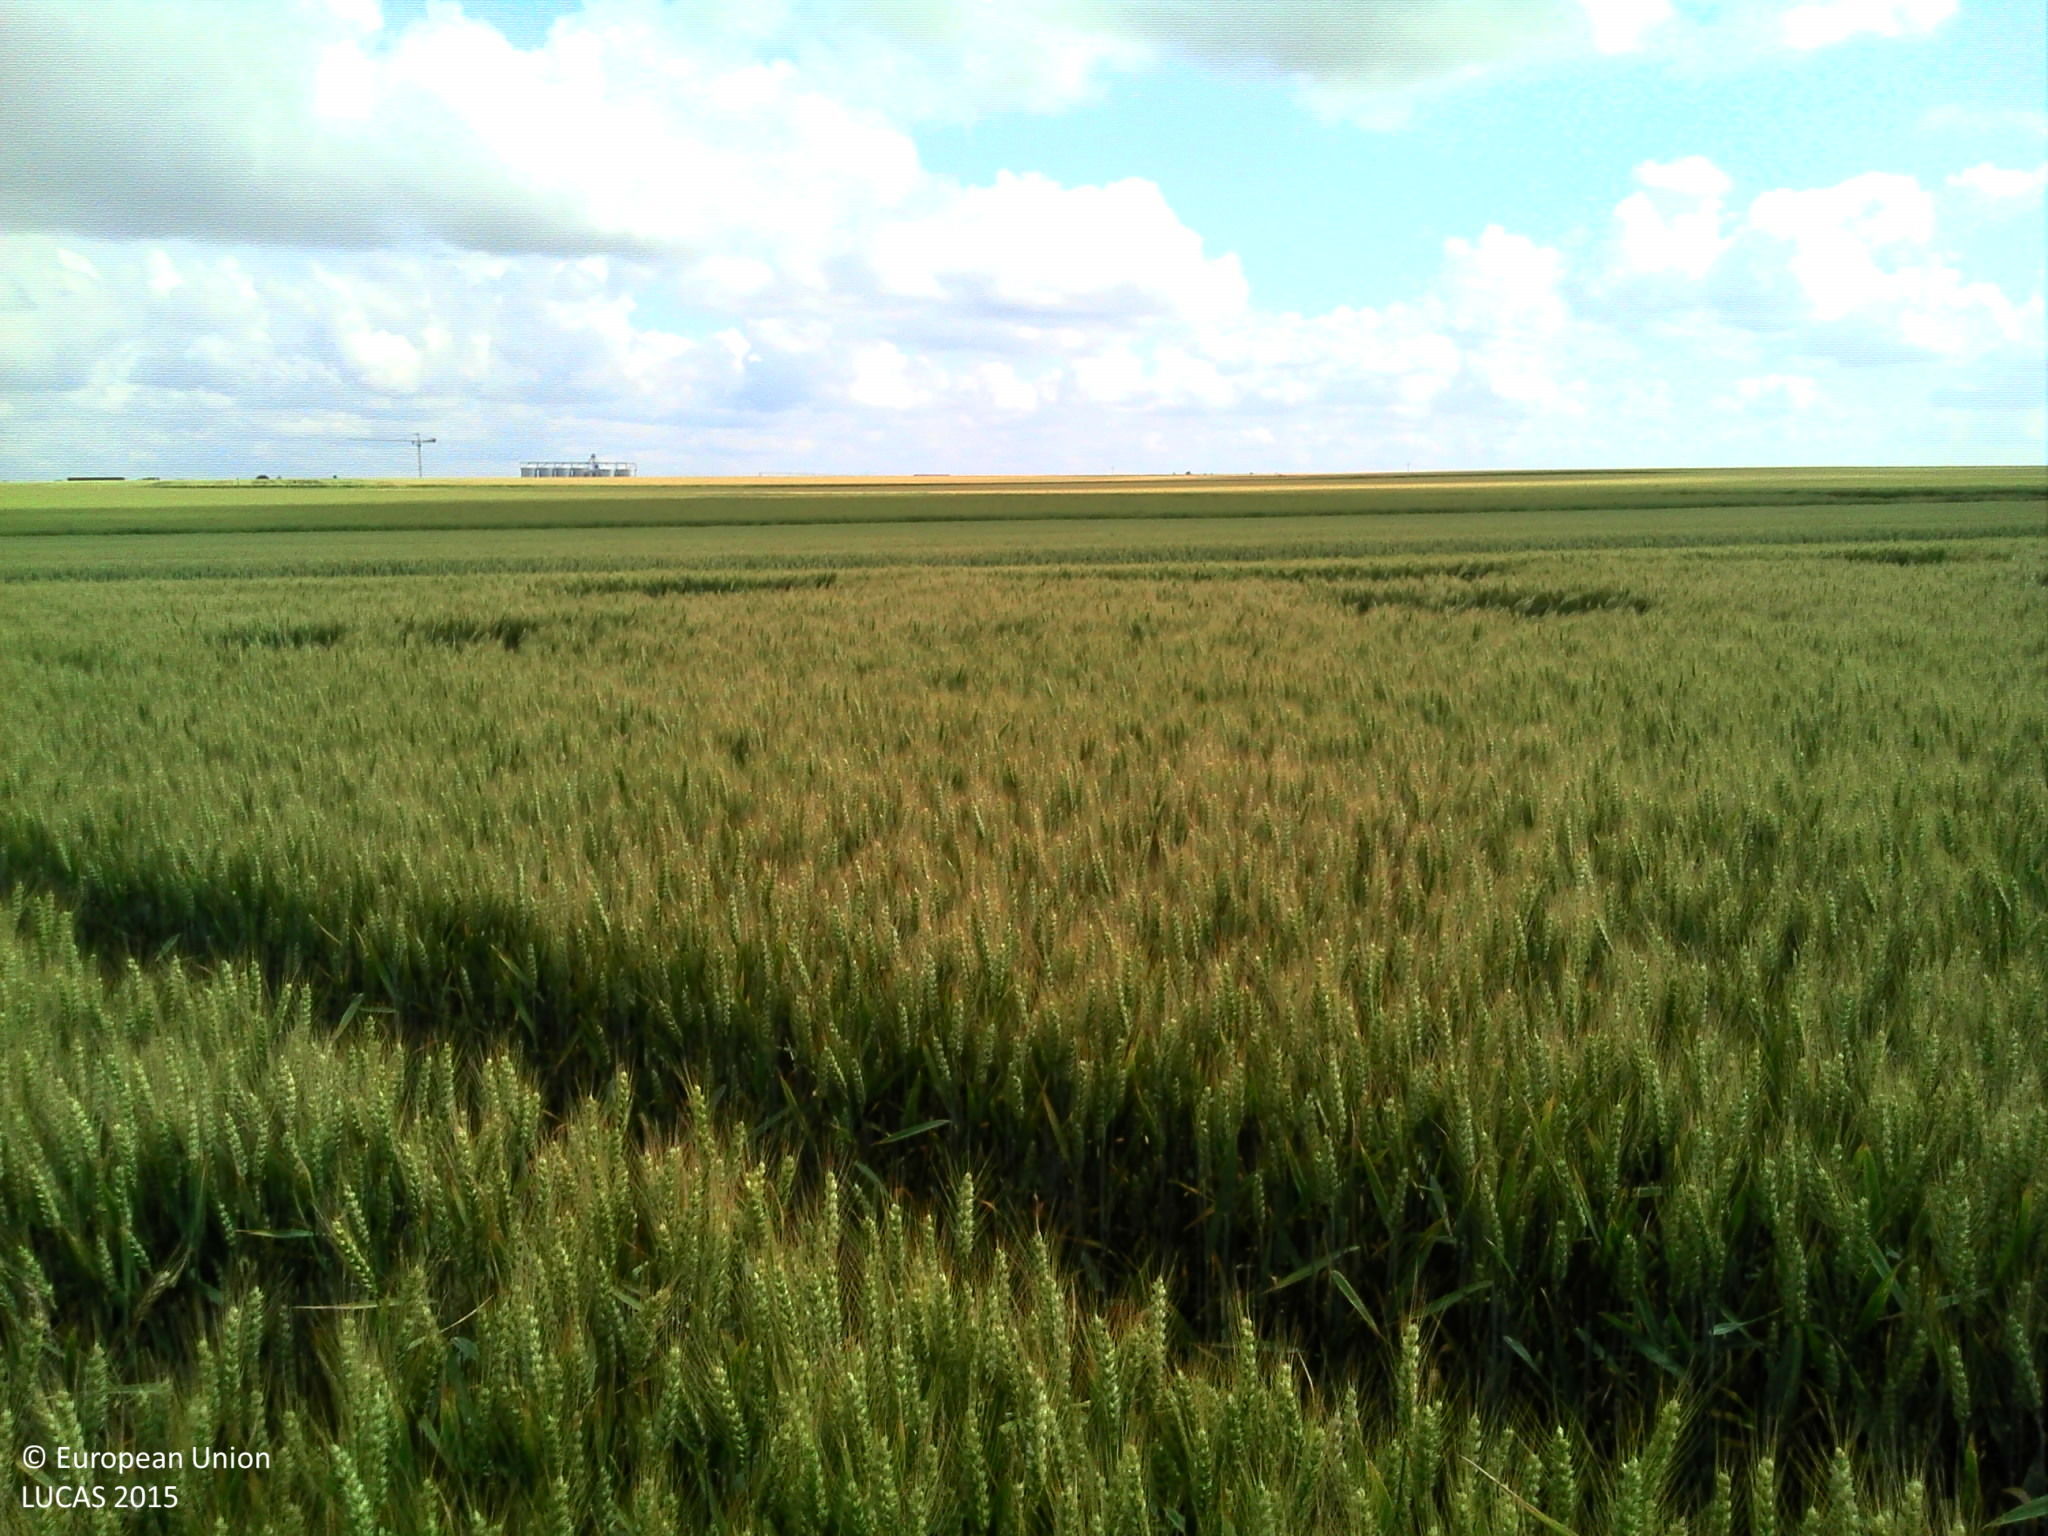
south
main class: Cropland
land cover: Common wheat
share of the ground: > 75 %
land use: Agriculture (excluding fallow land and kitchen gardens)
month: June
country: FR
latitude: 46.6681
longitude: 0.2685
